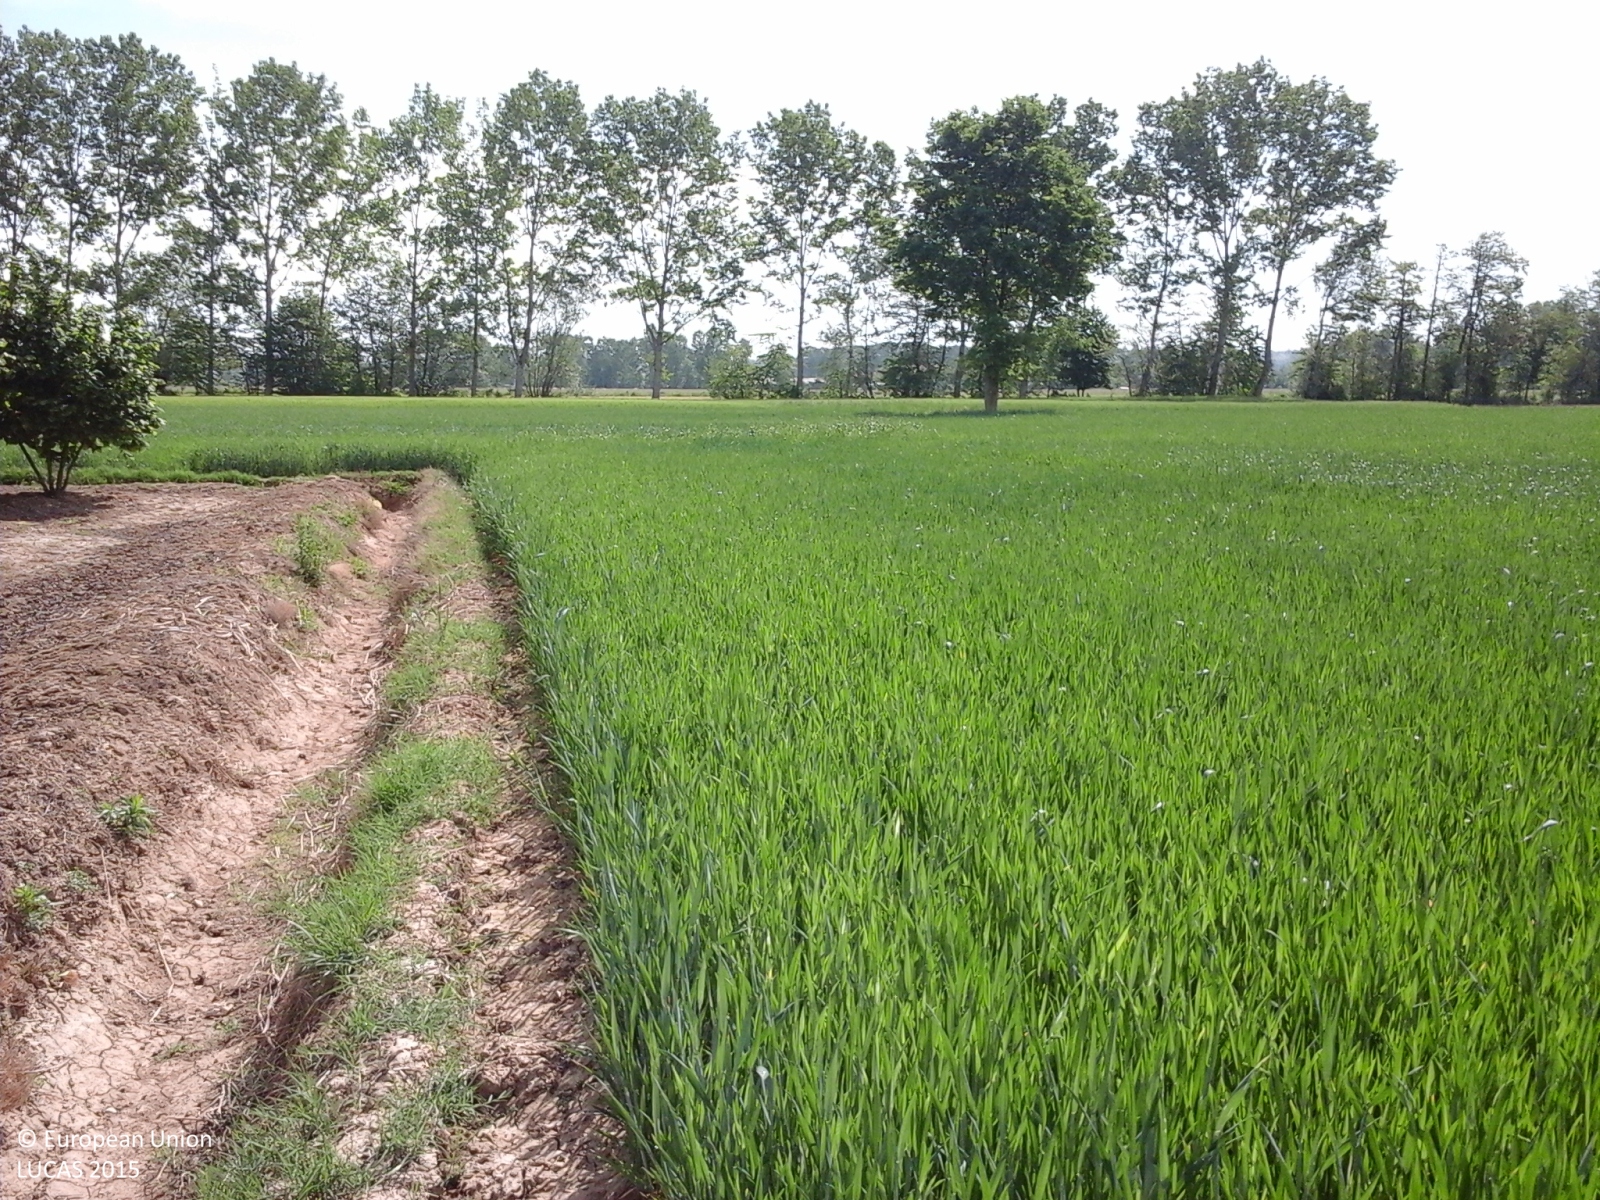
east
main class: Cropland
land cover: Common wheat
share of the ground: > 75 %
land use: Agriculture (excluding fallow land and kitchen gardens)
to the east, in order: Common wheat; Ditches and canals; Maize; Abandoned hedges; Ditches and canals; Abandoned hedges; Grass margins; Temporary grasslands; Ditches and canals; Temporary grasslands; Electric lines; Temporary grasslands; Ditches and canals; Temporary grasslands; Electric lines; Maize
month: May
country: IT
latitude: 44.5072
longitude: 7.7782
